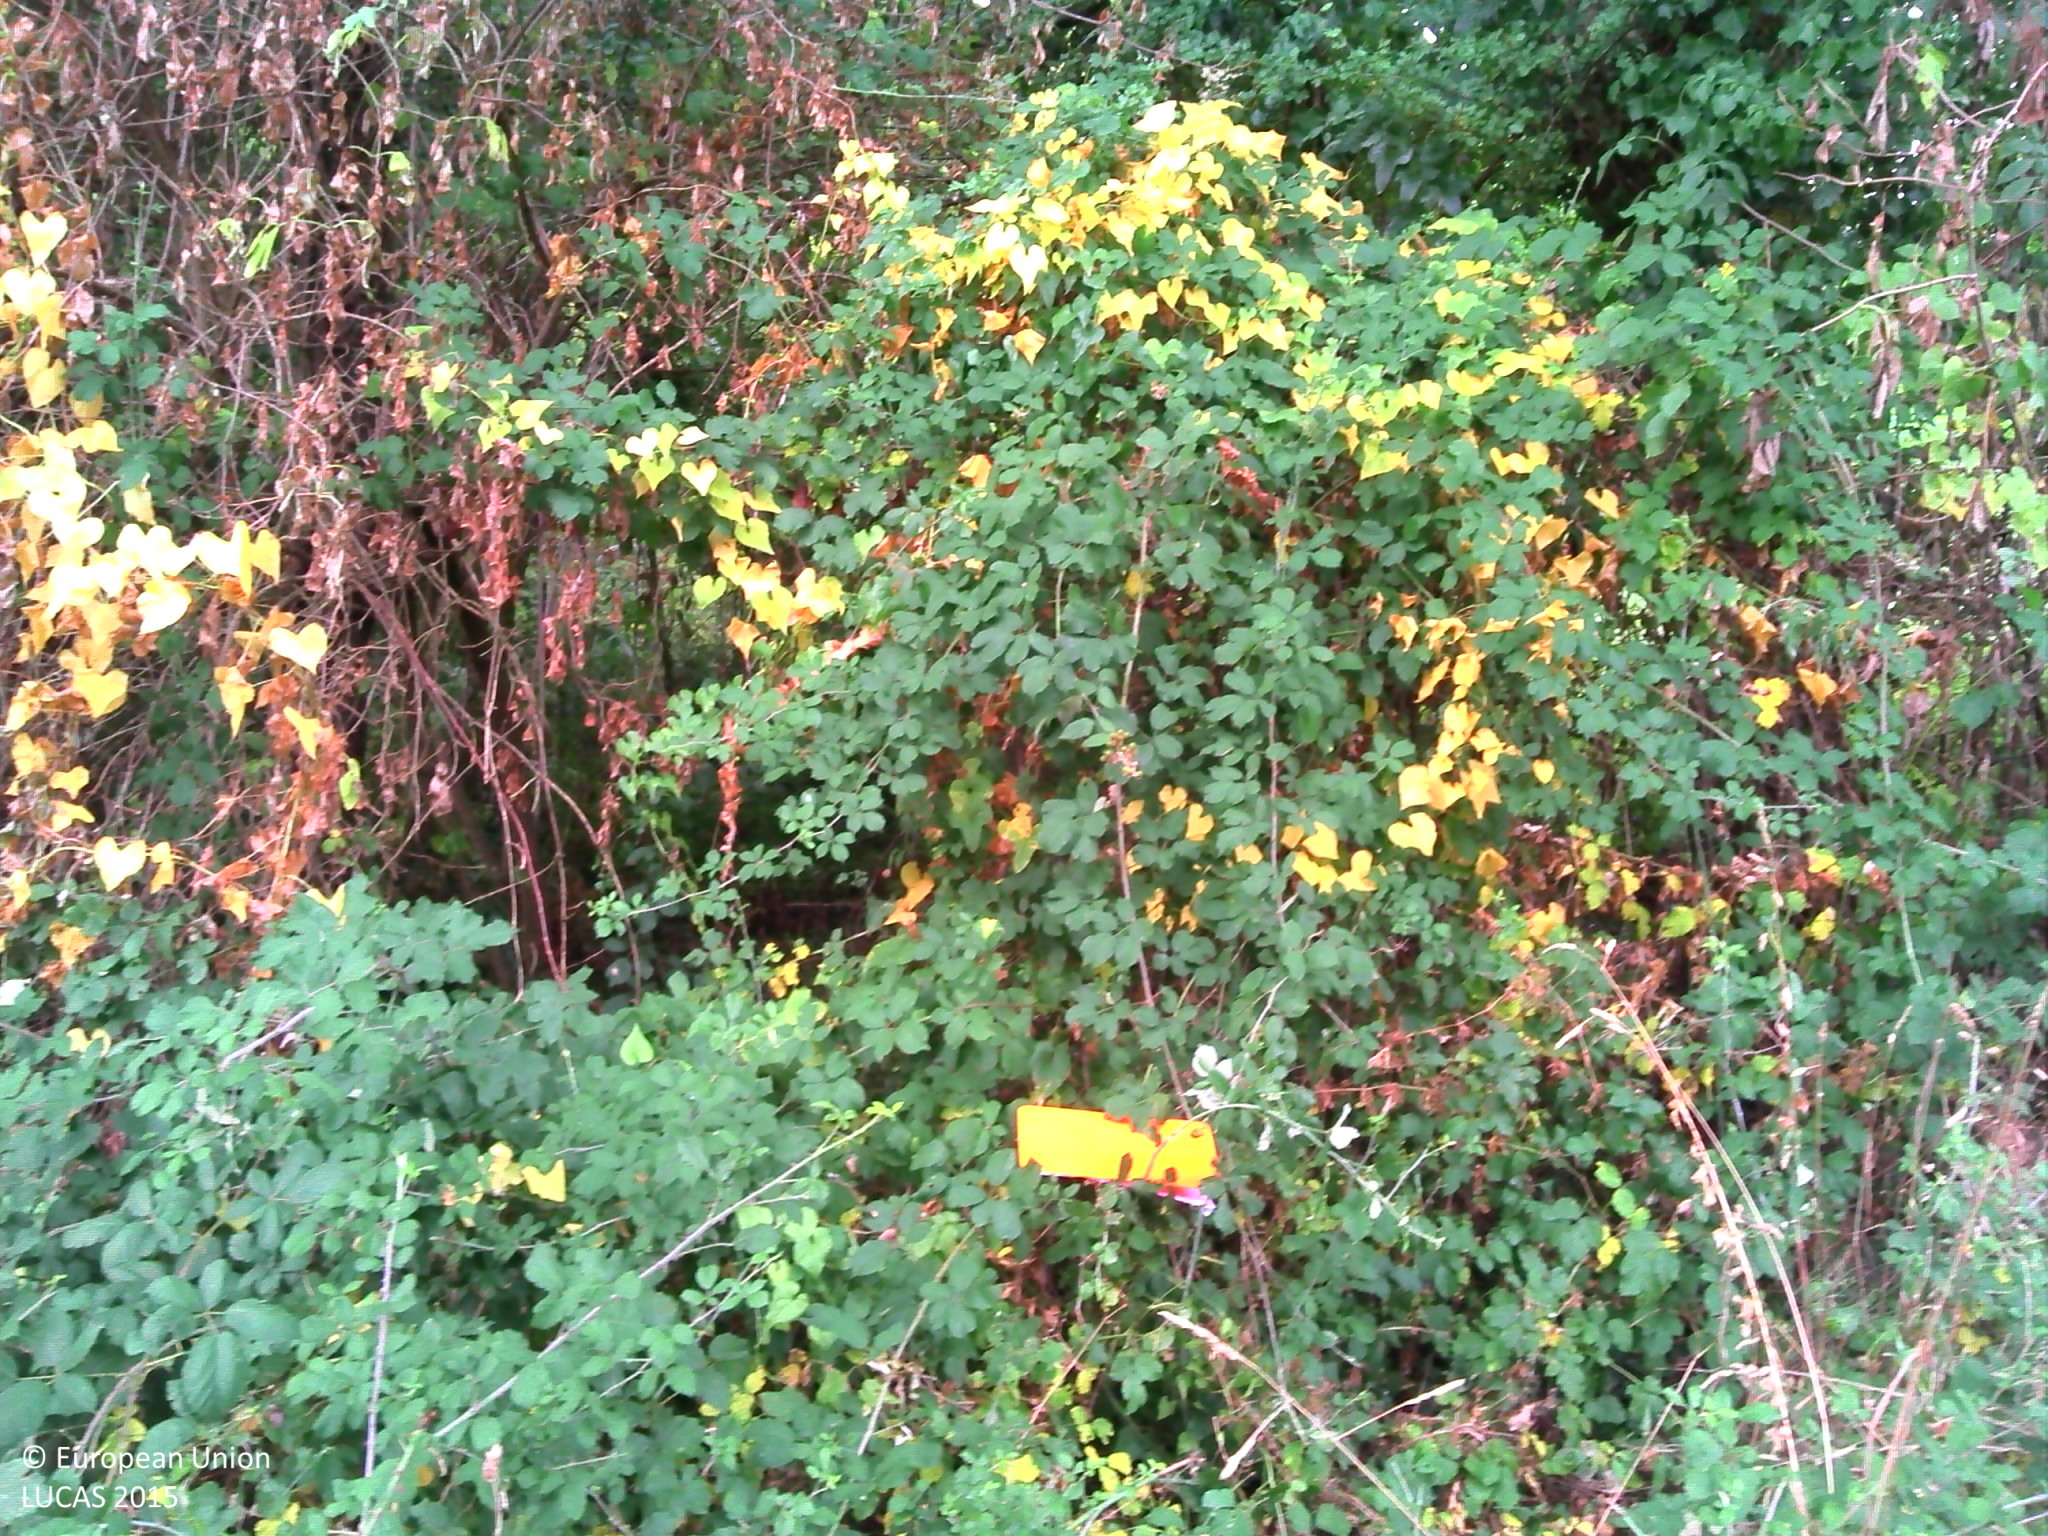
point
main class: Woodland
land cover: Broadleaved woodland
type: mesophytic deciduous forest
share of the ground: > 75 %
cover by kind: broadleaved forest trees 50 %, herbaceous plants 25 %, shrubs 20 %, lichens and mosses 5 %
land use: Forestry
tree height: > 5 m
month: July
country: FR
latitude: 44.9121
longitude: 0.5028
